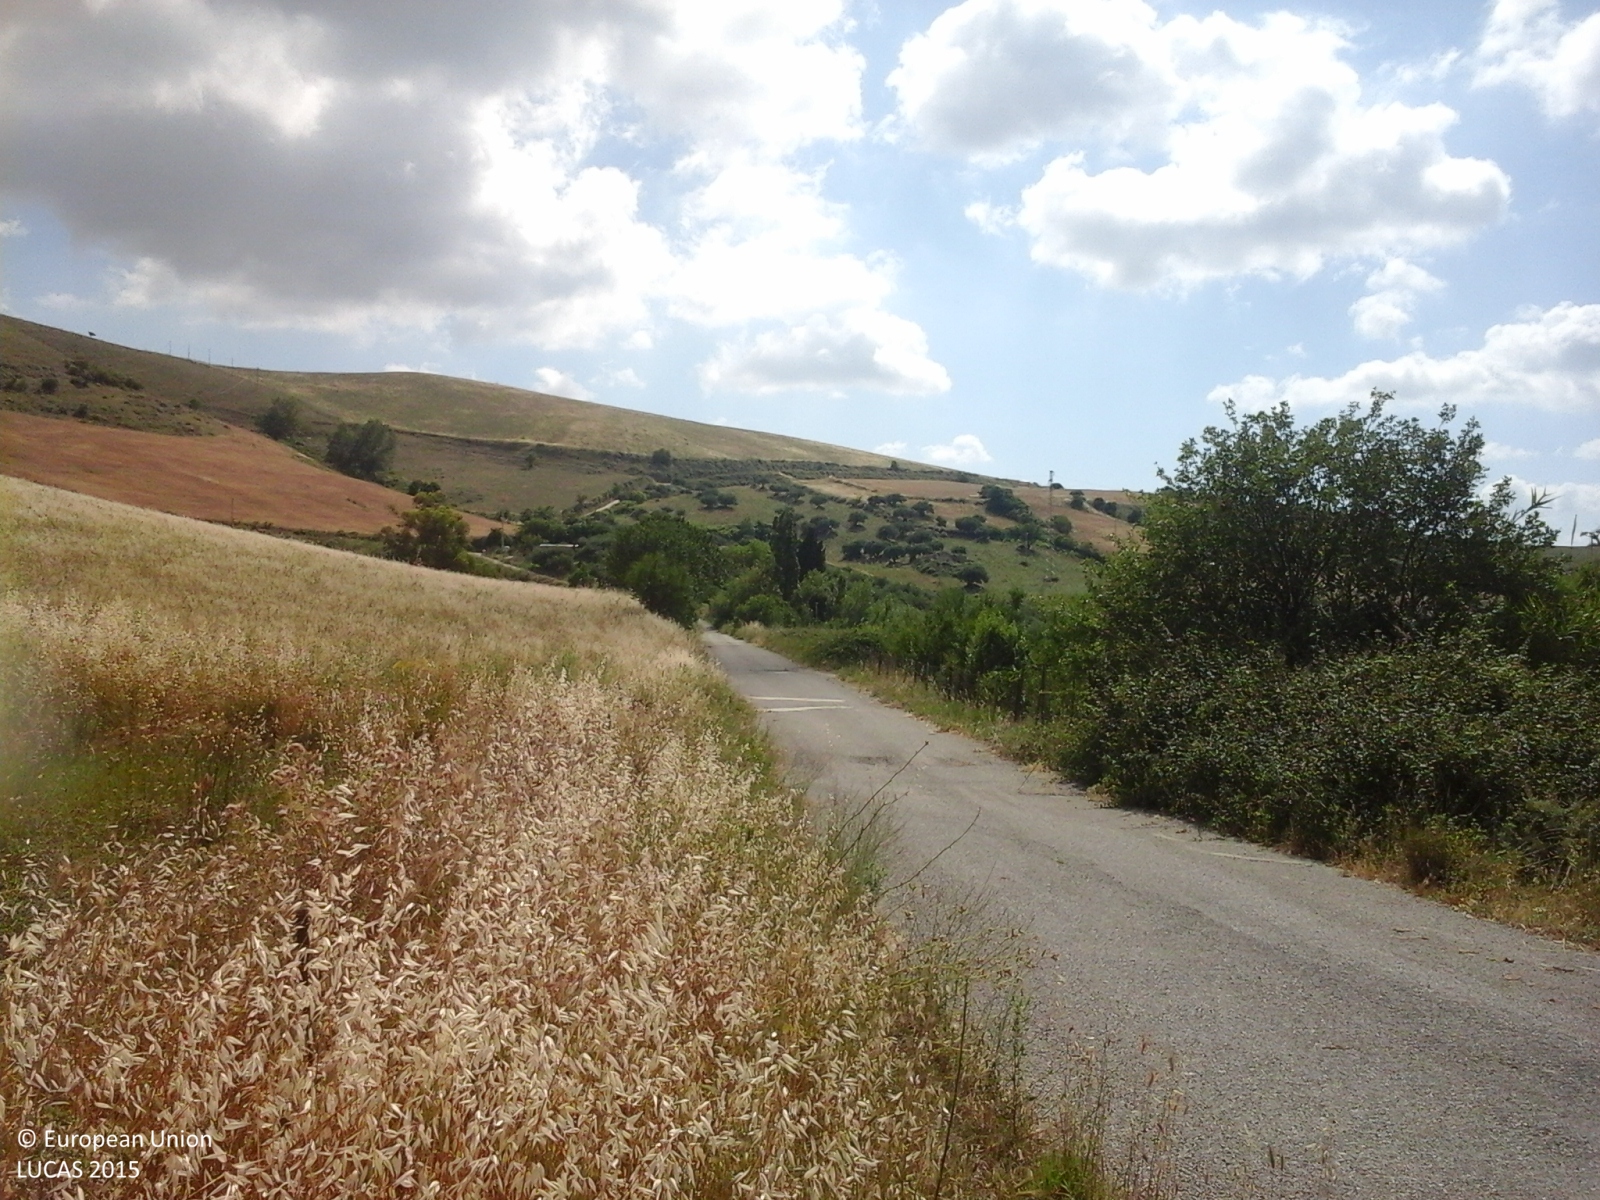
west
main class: Cropland
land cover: Durum wheat
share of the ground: > 75 %
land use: Agriculture (excluding fallow land and kitchen gardens)
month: June
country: IT
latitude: 37.7320
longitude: 13.1424
